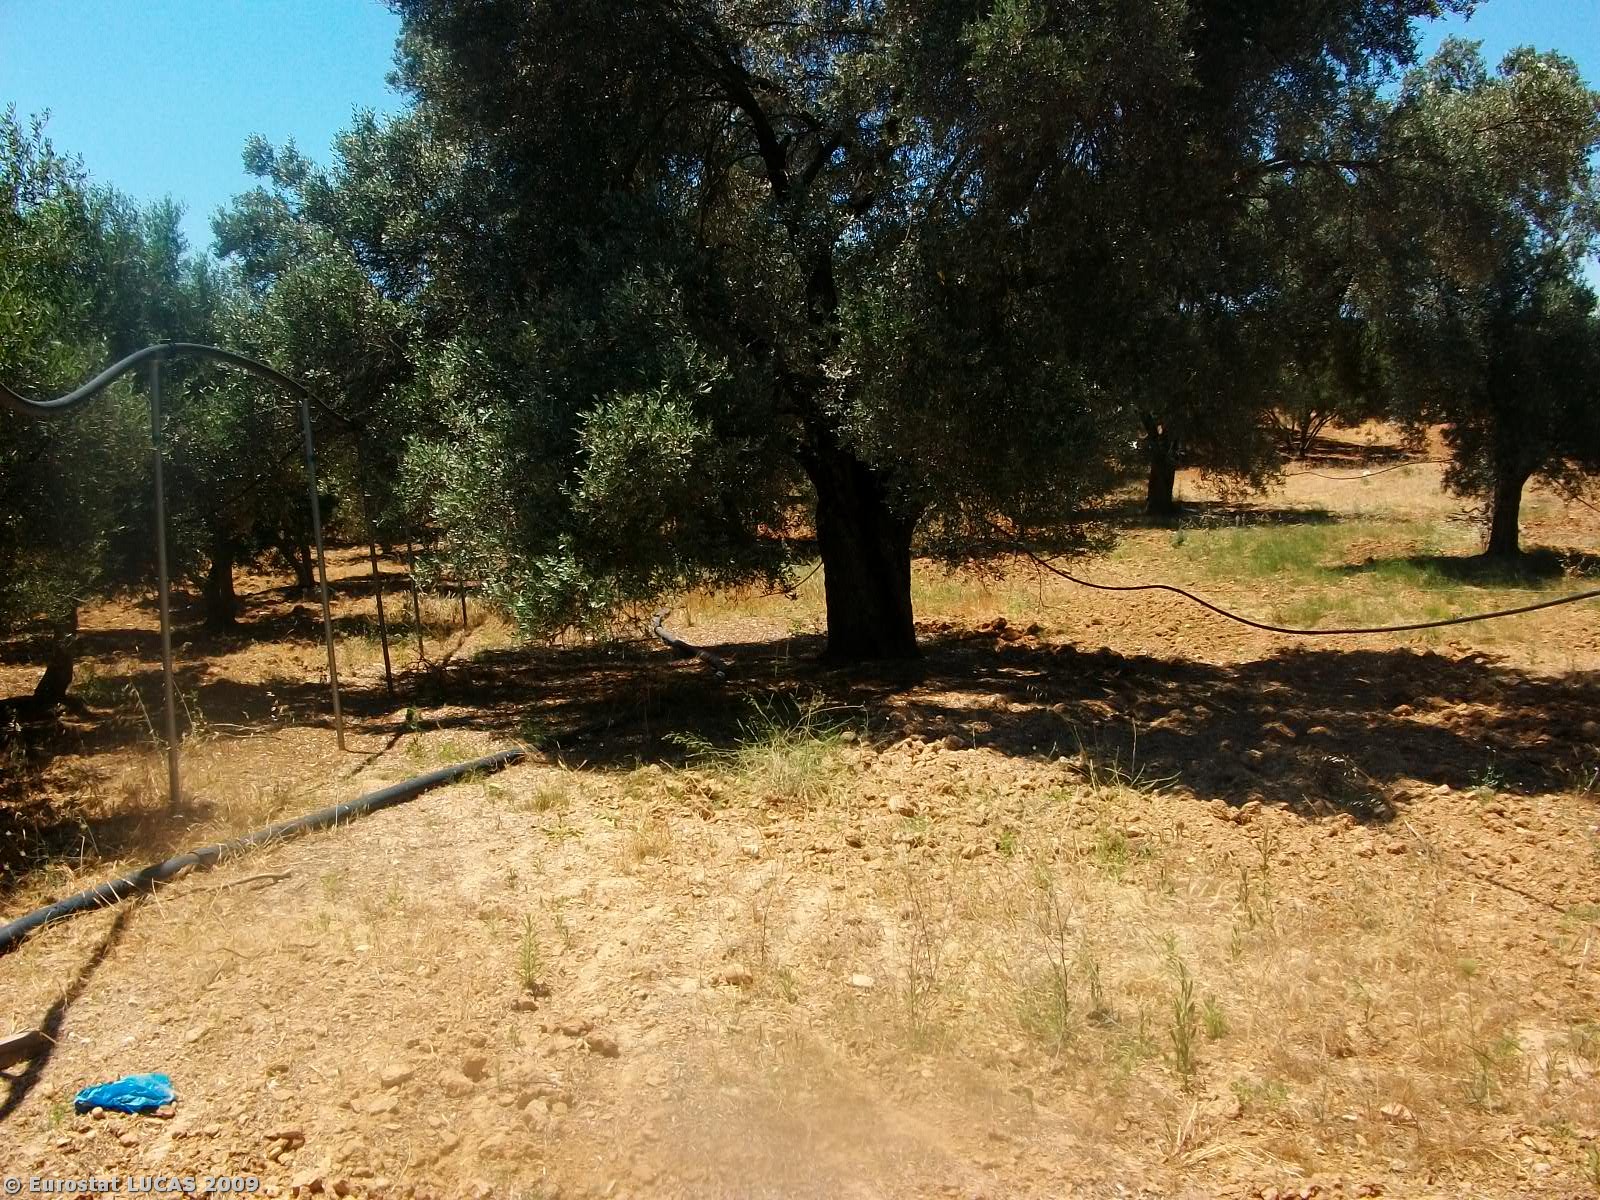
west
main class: Cropland
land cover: Olive groves
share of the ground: 50 - 75 %
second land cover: Bare land
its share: > 75 %
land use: Agriculture (excluding fallow land and kitchen gardens)
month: June
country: GR
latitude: 35.0473
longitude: 24.8393
